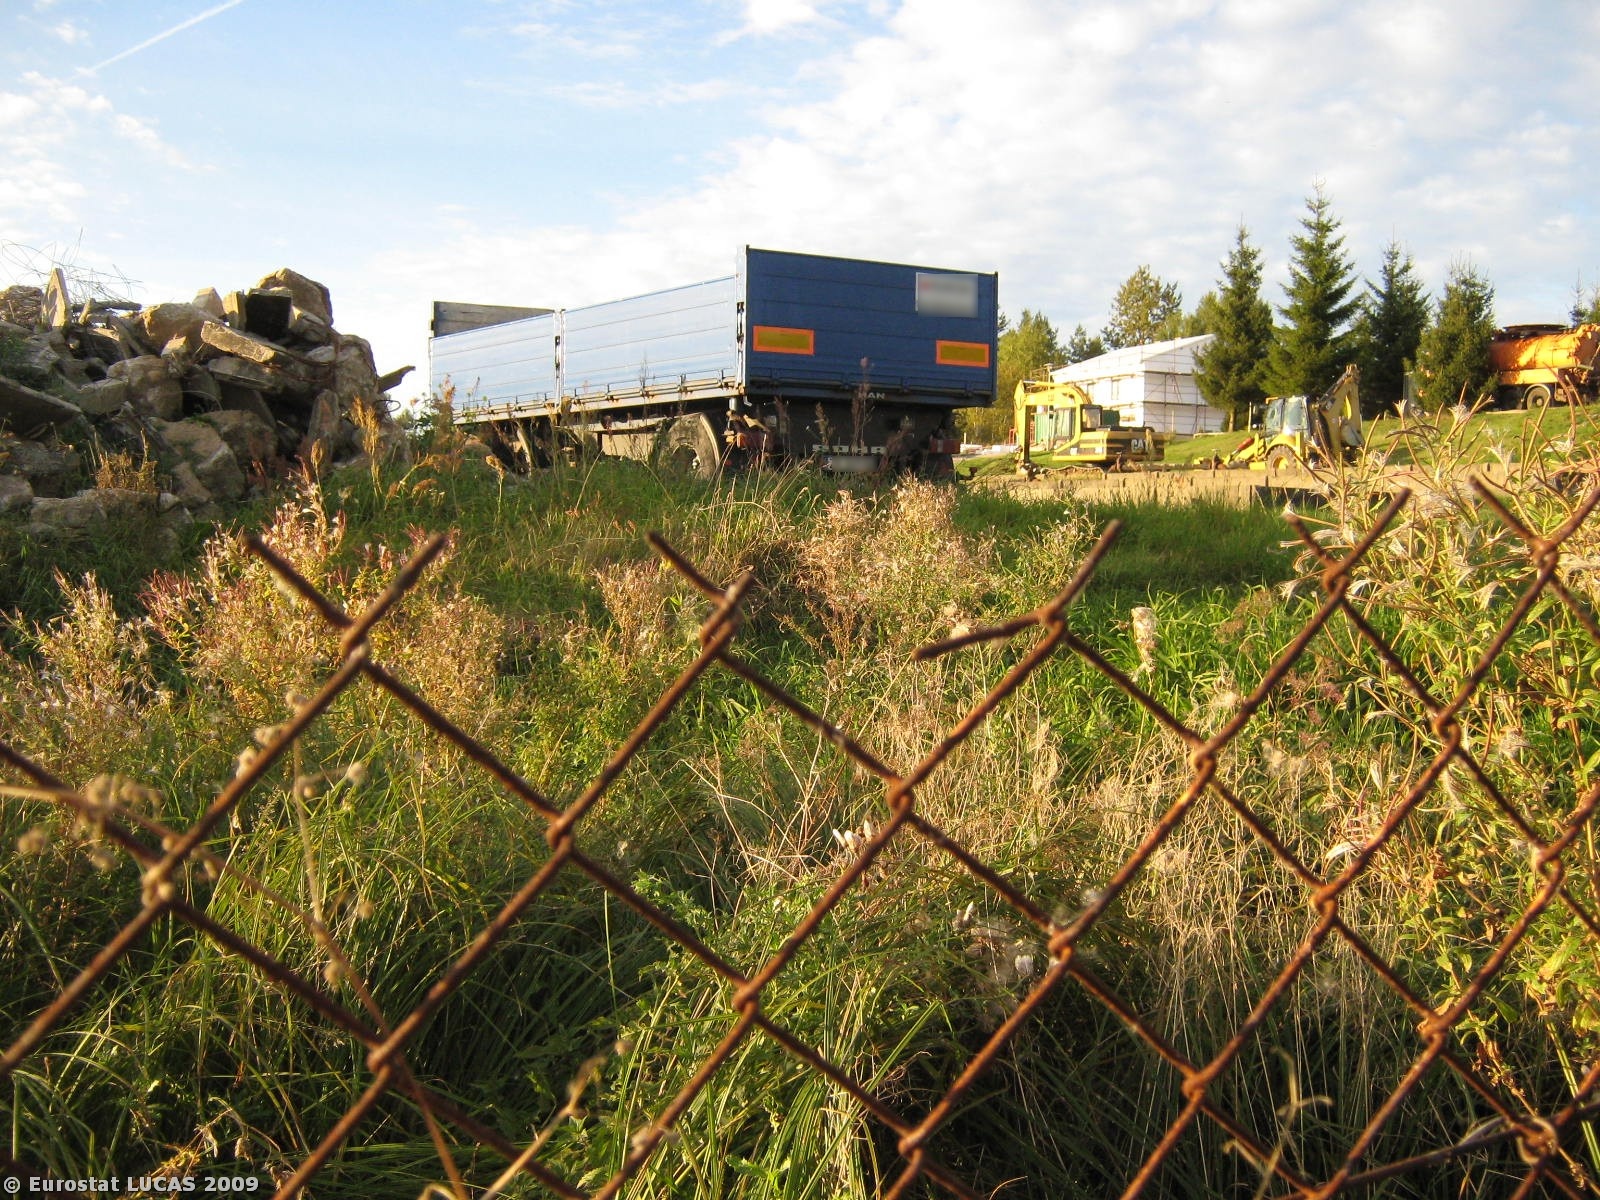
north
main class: Grassland
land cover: Grassland with sparse tree/shrub cover
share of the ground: > 75 %
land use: Community services
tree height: < 5 m
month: September
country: PL
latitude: 53.9627
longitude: 16.5760
